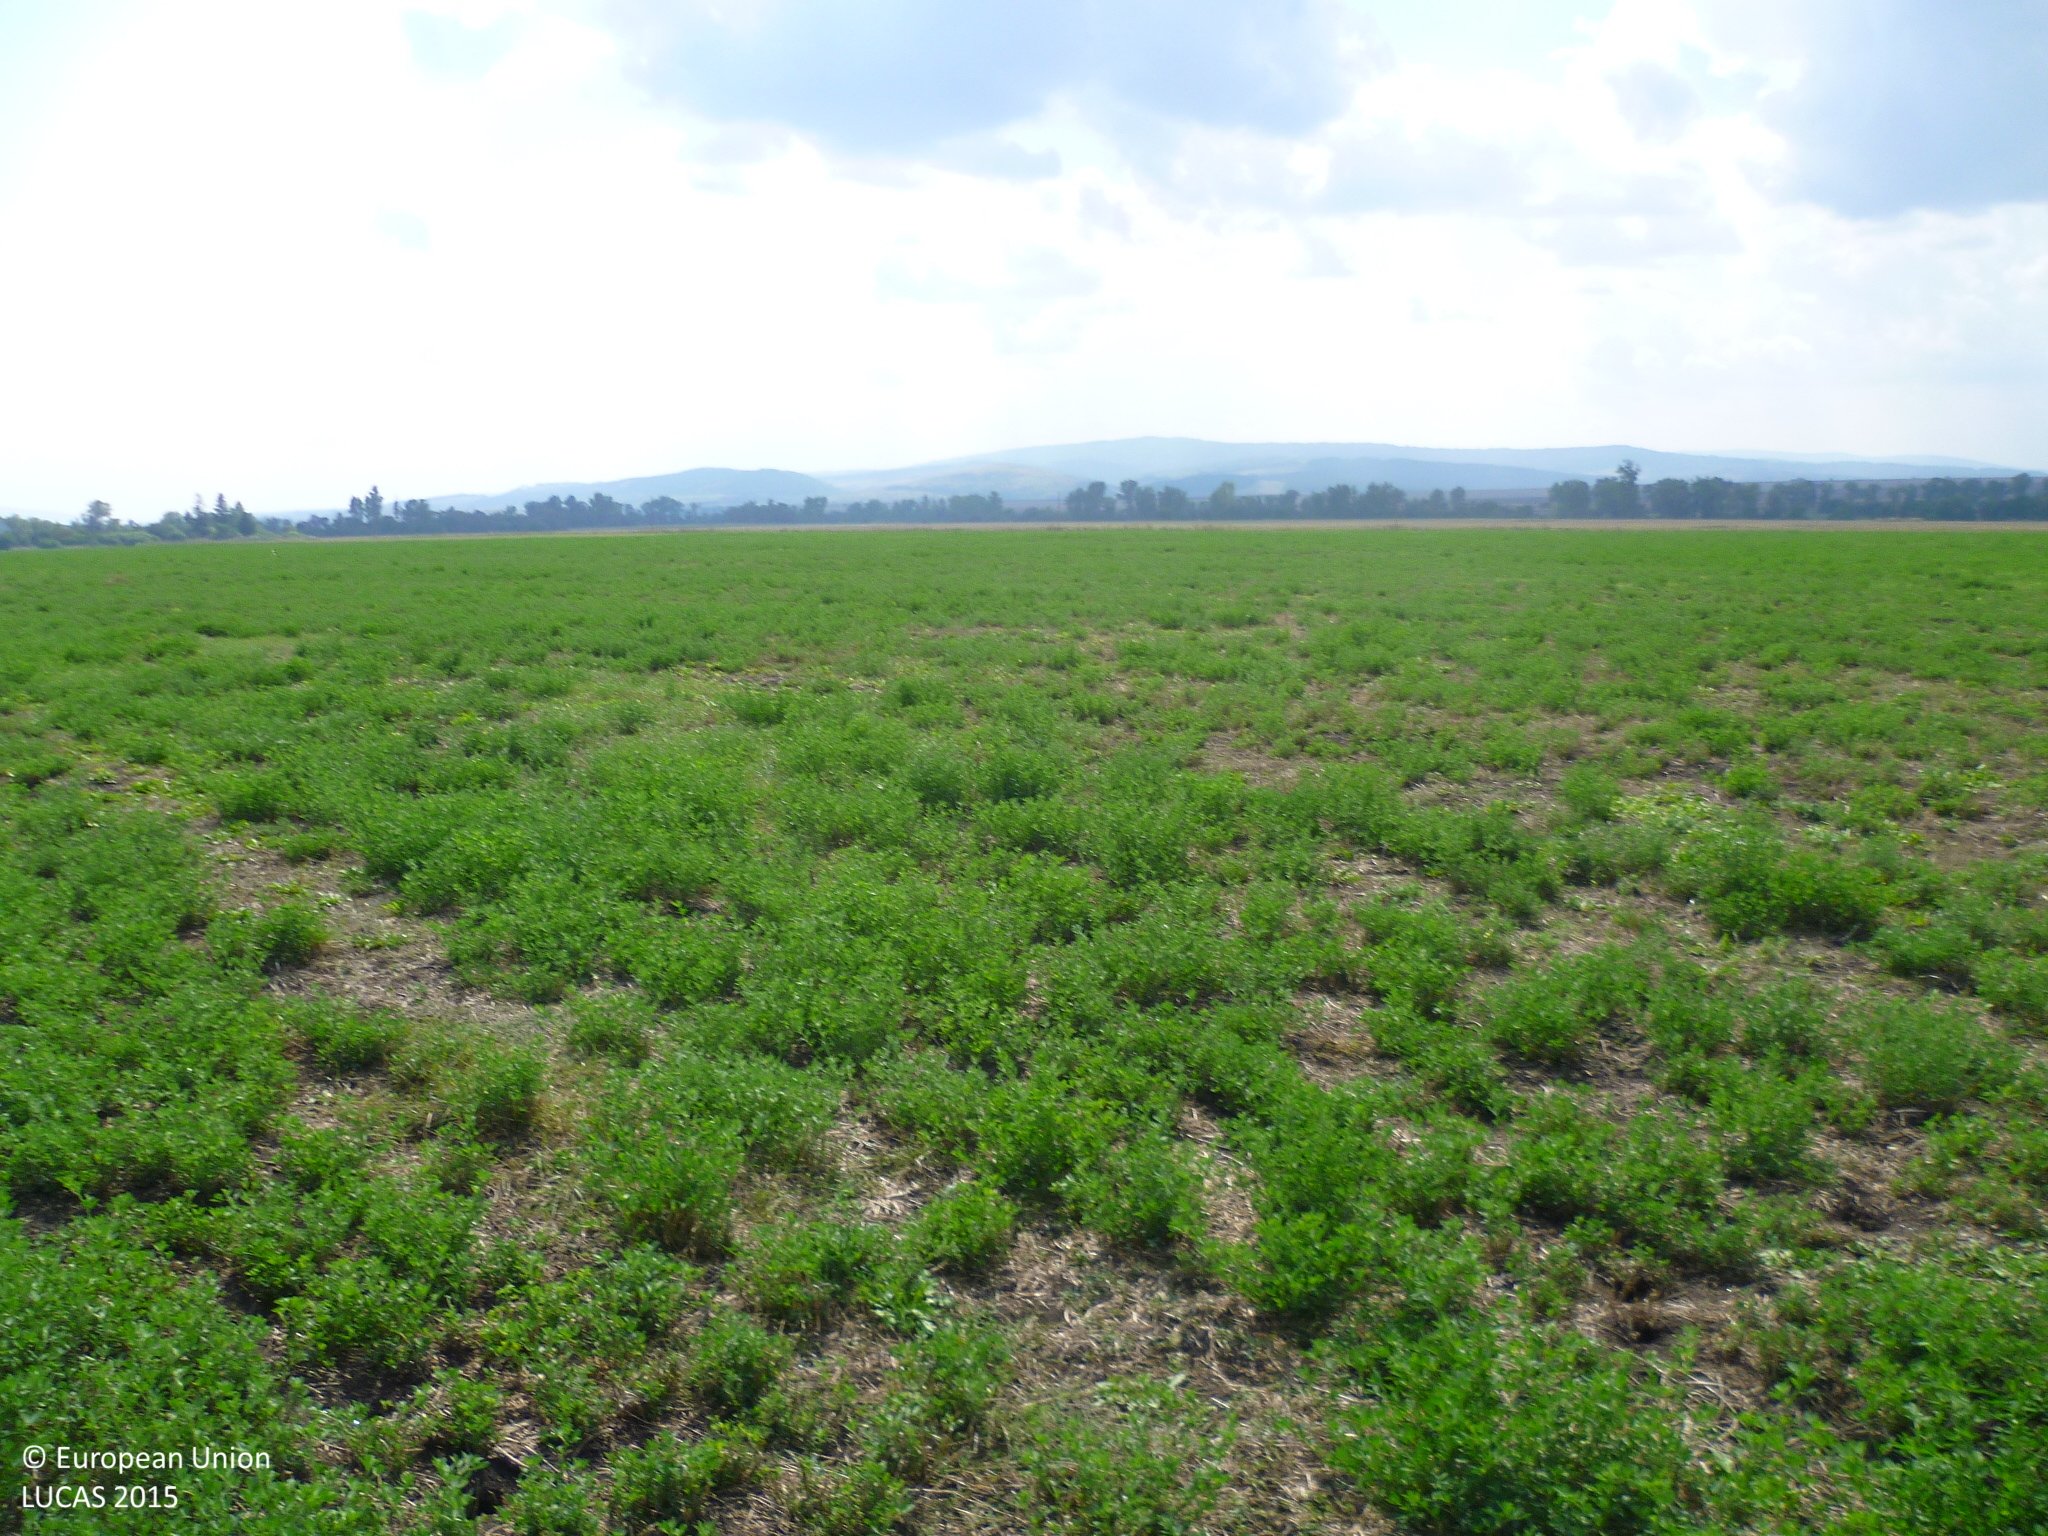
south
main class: Cropland
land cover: Lucerne
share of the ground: 50 - 75 %
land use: Agriculture (excluding fallow land and kitchen gardens)
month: September
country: BG
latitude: 42.7218
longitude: 22.8875
